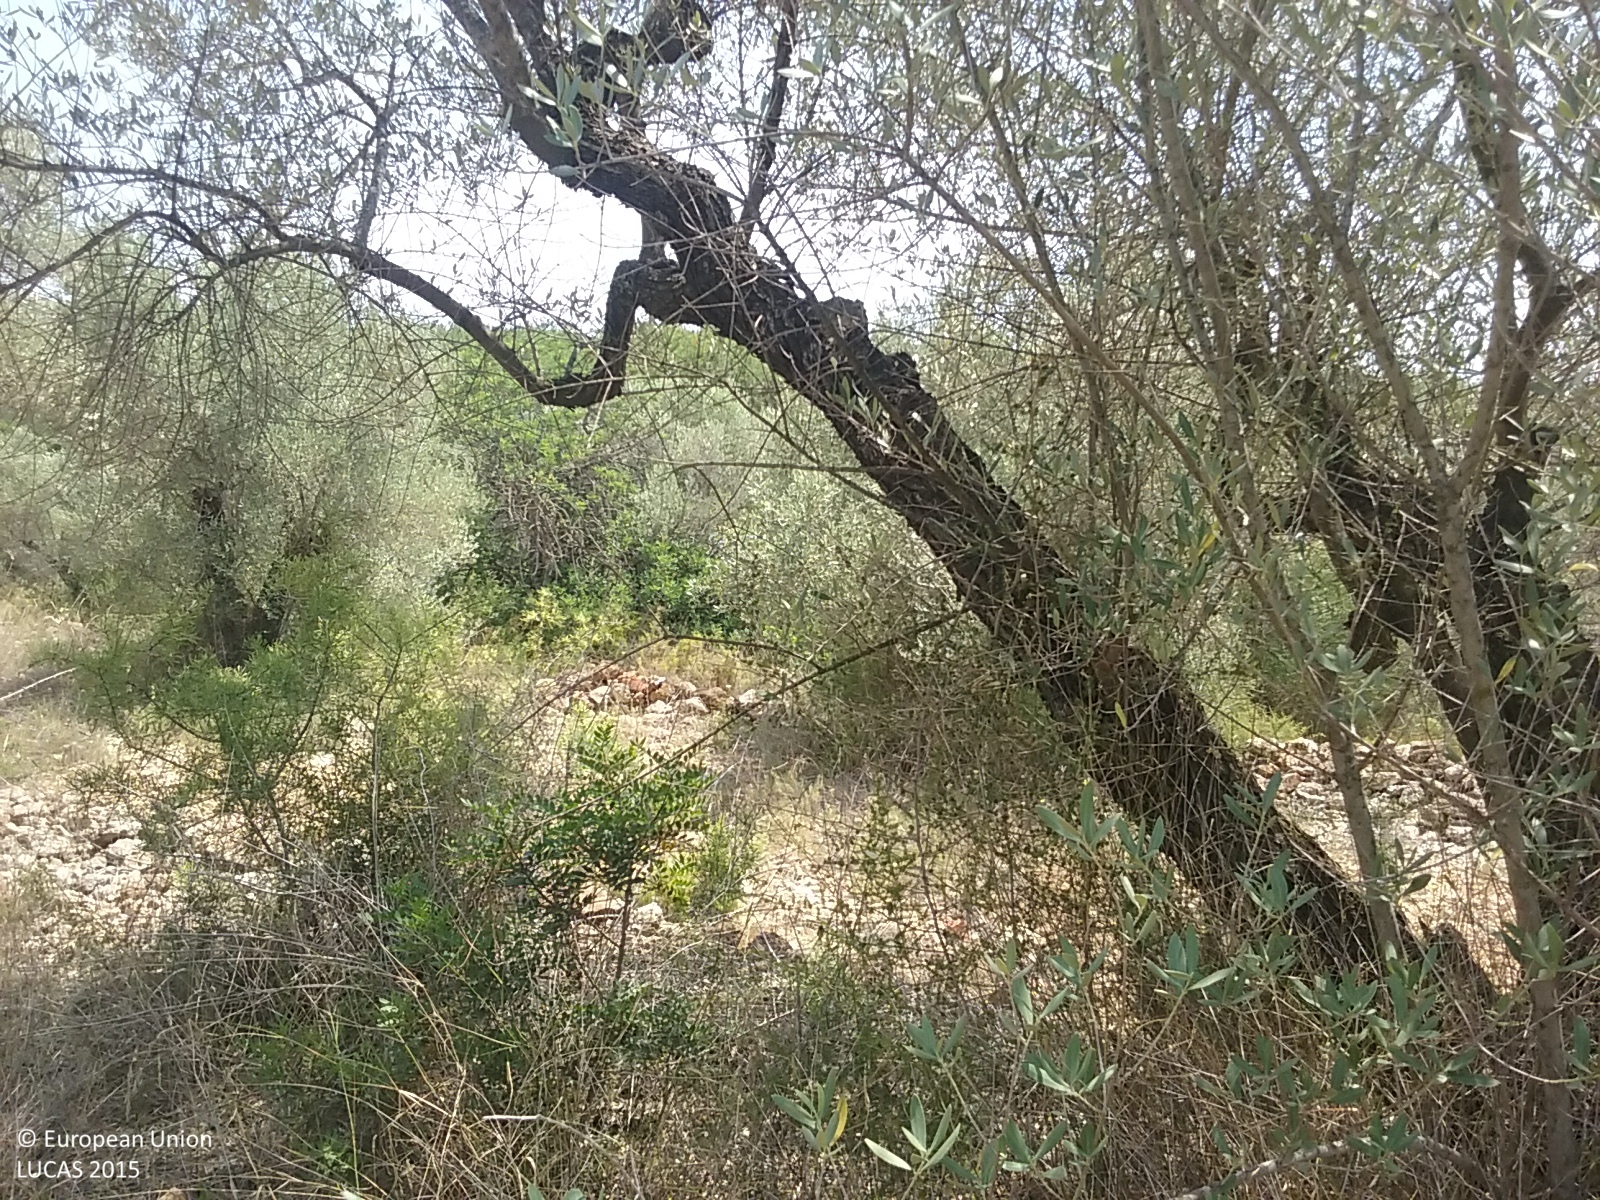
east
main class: Cropland
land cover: Olive groves
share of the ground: 25 - 50 %
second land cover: Grassland without tree/shrub cover
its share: 50 - 75 %
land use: Abandoned areas
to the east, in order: Olive groves; Grassland without tree/shrub cover; Dry stone walls; Olive groves; Dry stone walls; Olive groves; Dry stone walls; Olive groves; Dry stone walls; Olive groves; Dry stone walls; Olive groves; Grass margins; Paved roads, cycling and walking lanes; Ditches and canals; Abandoned hedges; Dry stone walls; Nuts trees; Dry stone walls; Nuts trees; Dry stone walls; Nuts trees; Dry stone walls; Nuts trees; Dry stone walls; Nuts trees; Dry stone walls; Nuts trees; Dry stone walls; Nuts trees; Dry stone walls; Olive groves; Dry stone walls; Grassland without tree/shrub cover; Nuts trees; Dry stone walls; Fences; Artificial constructions in urban areas; Fences; Paved roads, cycling and walking lanes; Grass margins; Dry stone walls; Olive groves; Dry stone walls; Olive groves; Dry stone walls; Olive groves
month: July
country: ES
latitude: 40.1495
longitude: -0.0629
